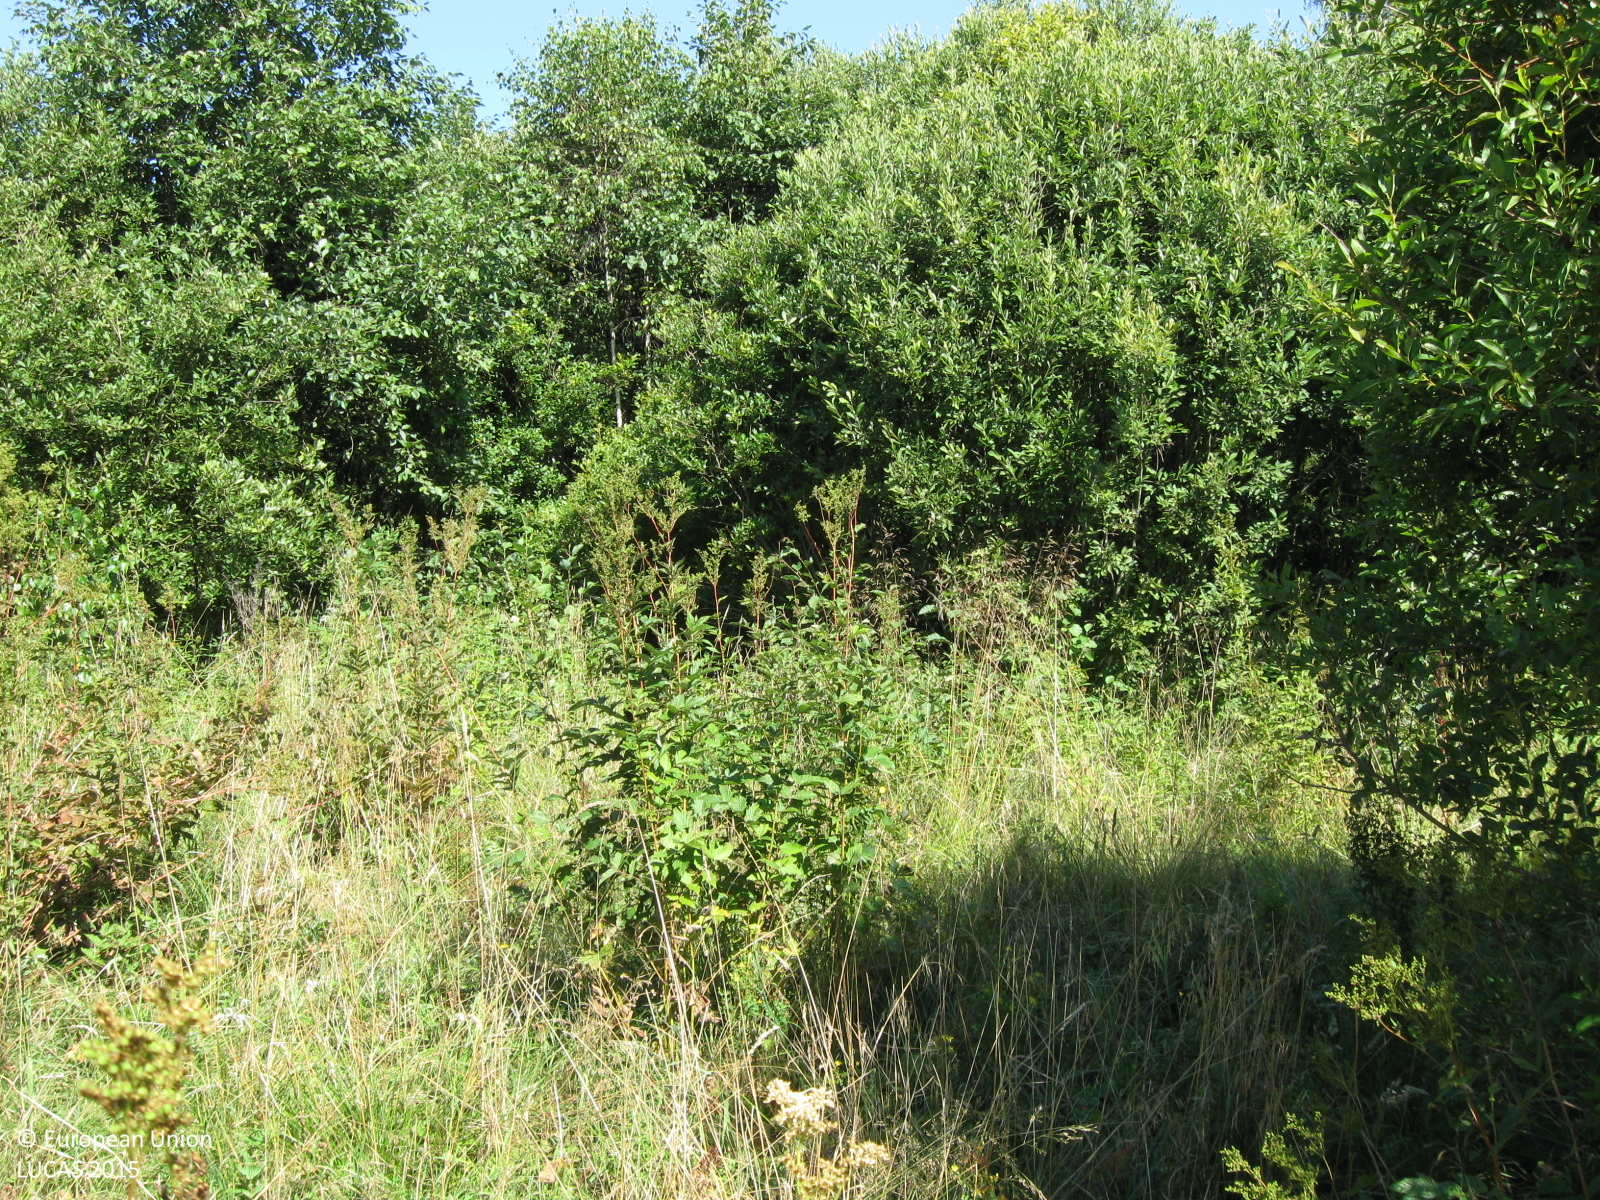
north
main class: Woodland
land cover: Broadleaved woodland
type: non-riverine alder, birch or aspen forest
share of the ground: 25 - 50 %
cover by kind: herbaceous plants 60 %, broadleaved forest trees 30 %, shrubs 10 %
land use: Forestry
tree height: < 5 m
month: August
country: LT
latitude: 55.3865
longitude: 22.5483
